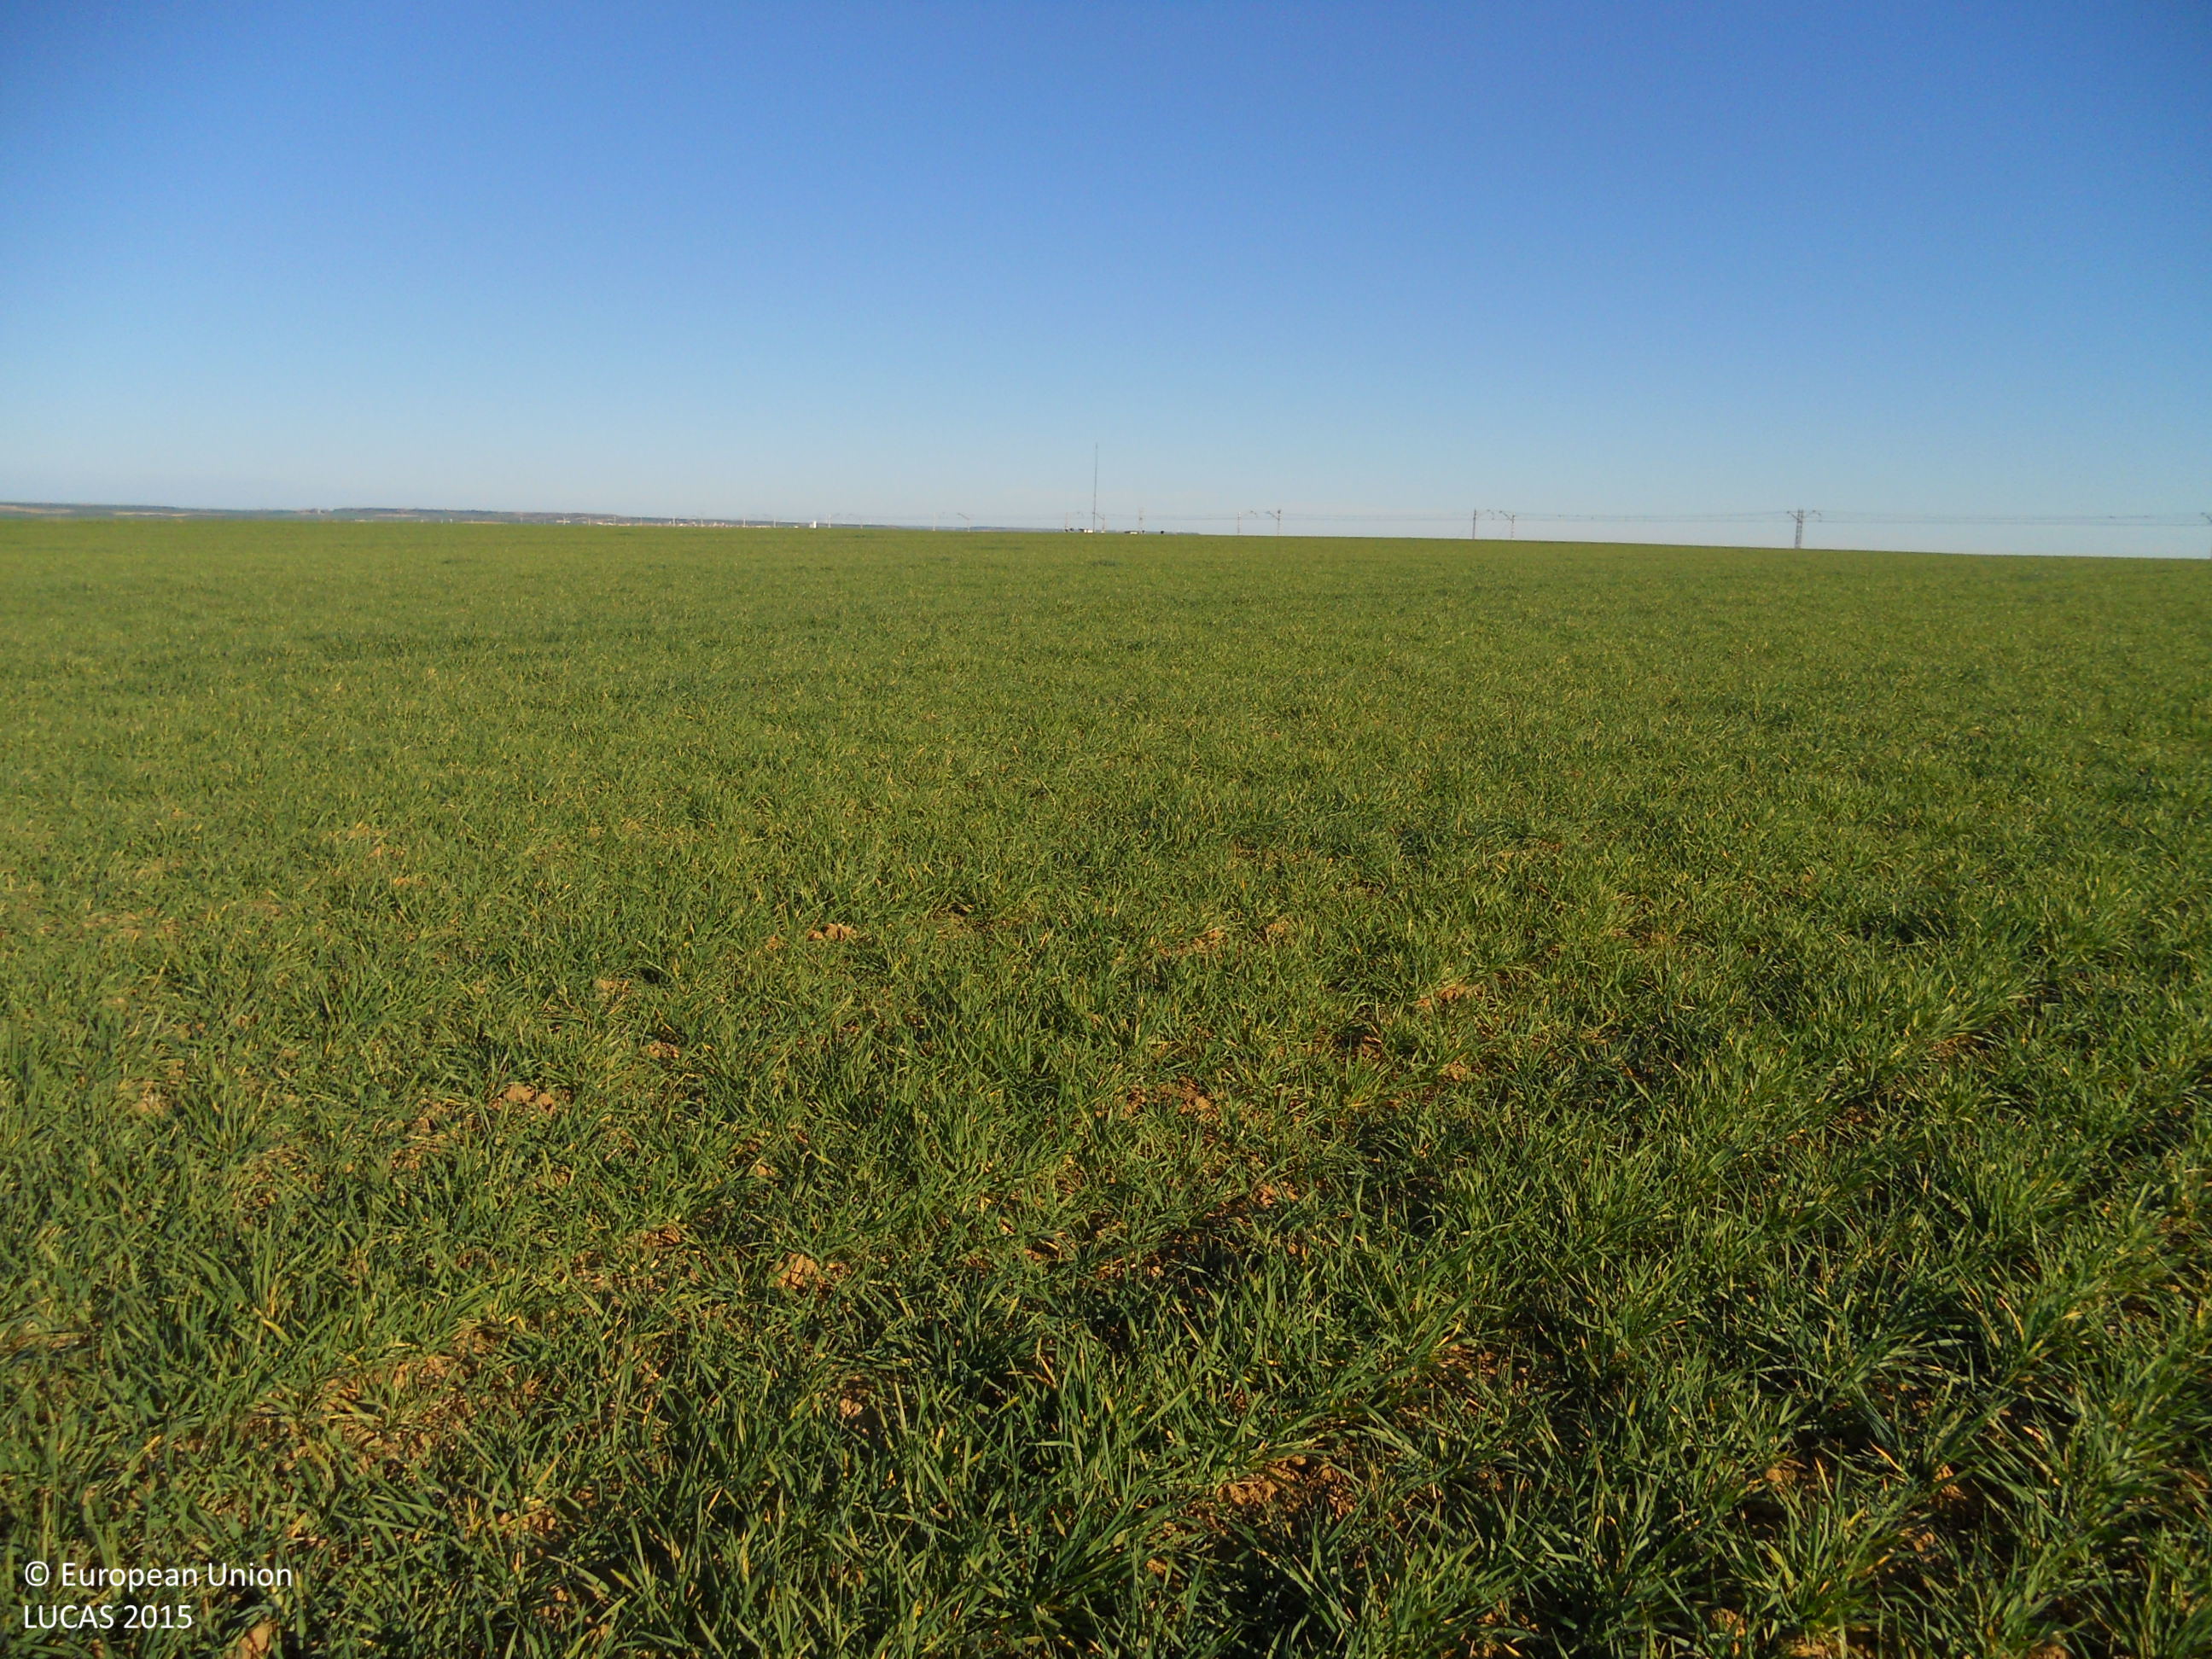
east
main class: Cropland
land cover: Barley
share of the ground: > 75 %
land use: Agriculture (excluding fallow land and kitchen gardens)
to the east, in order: Barley
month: March
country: ES
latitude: 42.1813
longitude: -4.8117
